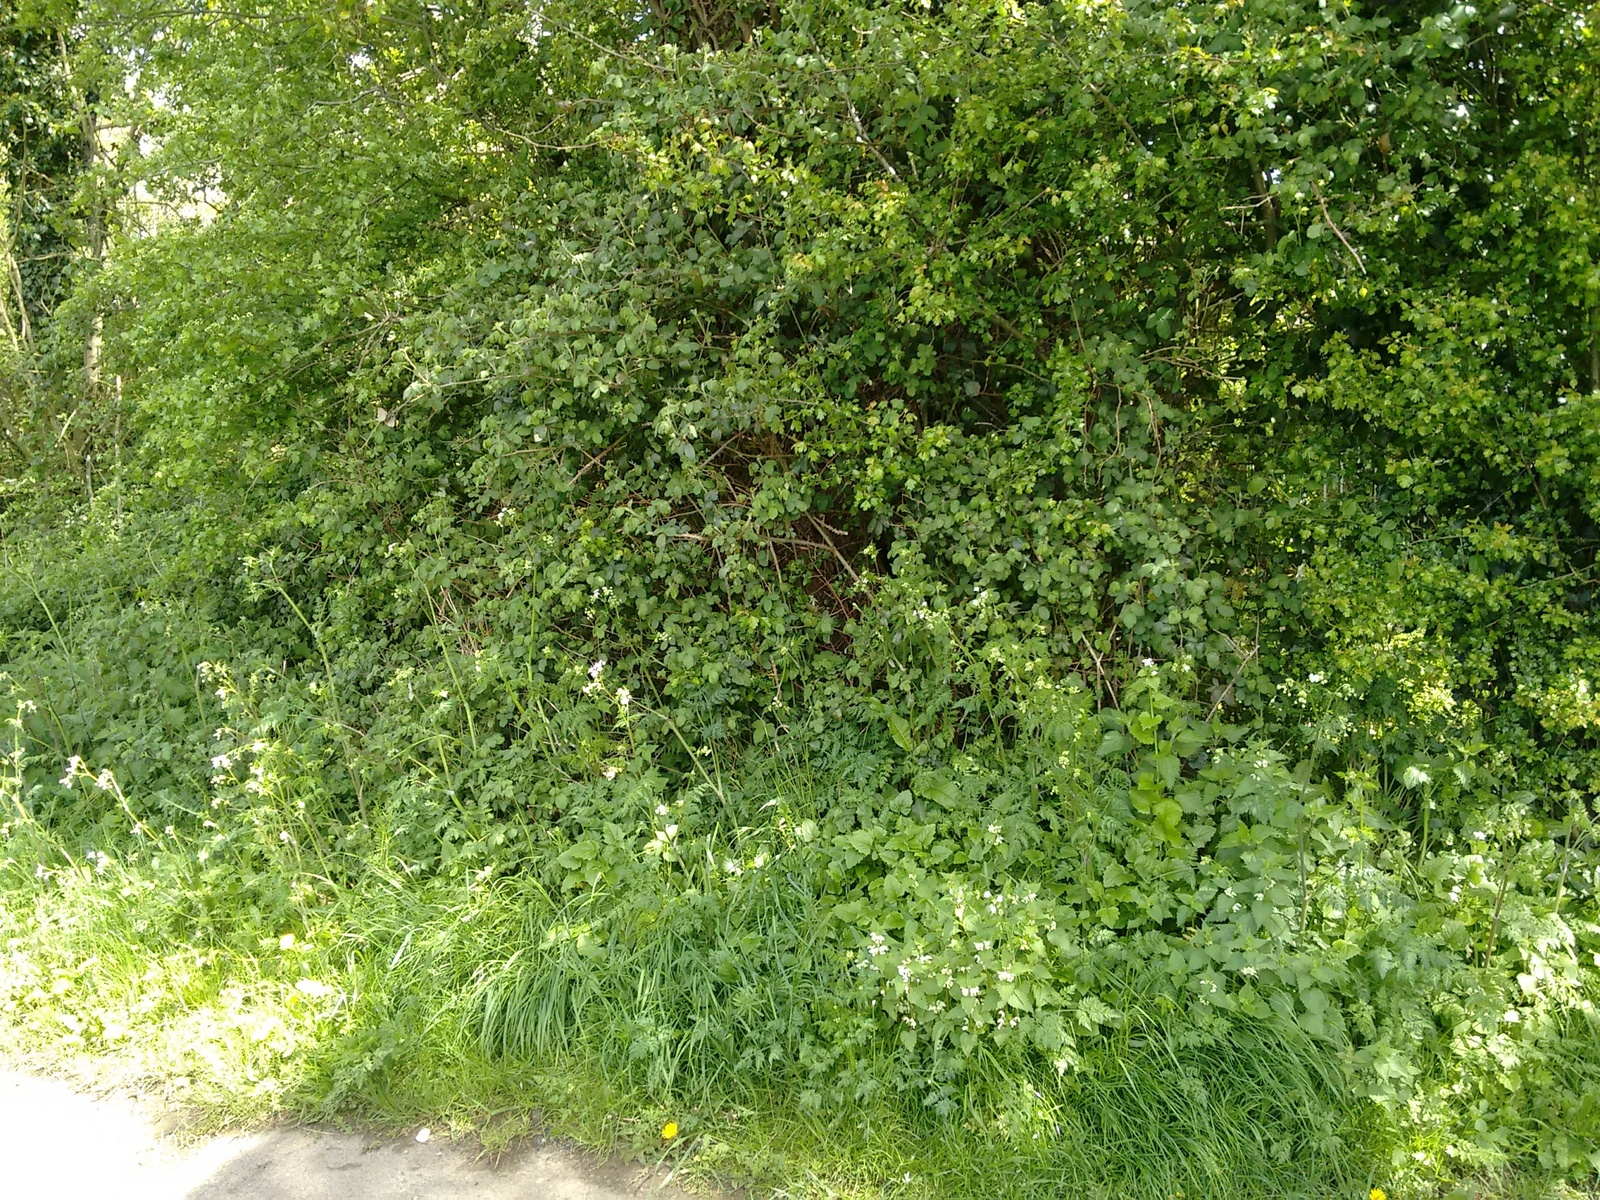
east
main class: Woodland
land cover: Broadleaved woodland
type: mesophytic deciduous forest
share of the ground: > 75 %
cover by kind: broadleaved forest trees 90 %, shrubs 10 %
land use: Semi-natural and natural areas not in use
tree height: > 5 m
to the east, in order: Broadleaved woodland; Inland fresh running water; Broadleaved woodland; Common wheat; Grass margins; Fences; Tracks; Managed hedges; Tracks; Grass margins; Inland fresh running water; Broadleaved woodland; Inland fresh running water; Broadleaved woodland; Tracks; Broadleaved woodland; Grassland without tree/shrub cover
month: May
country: GB
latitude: 51.1966
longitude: 0.2529
